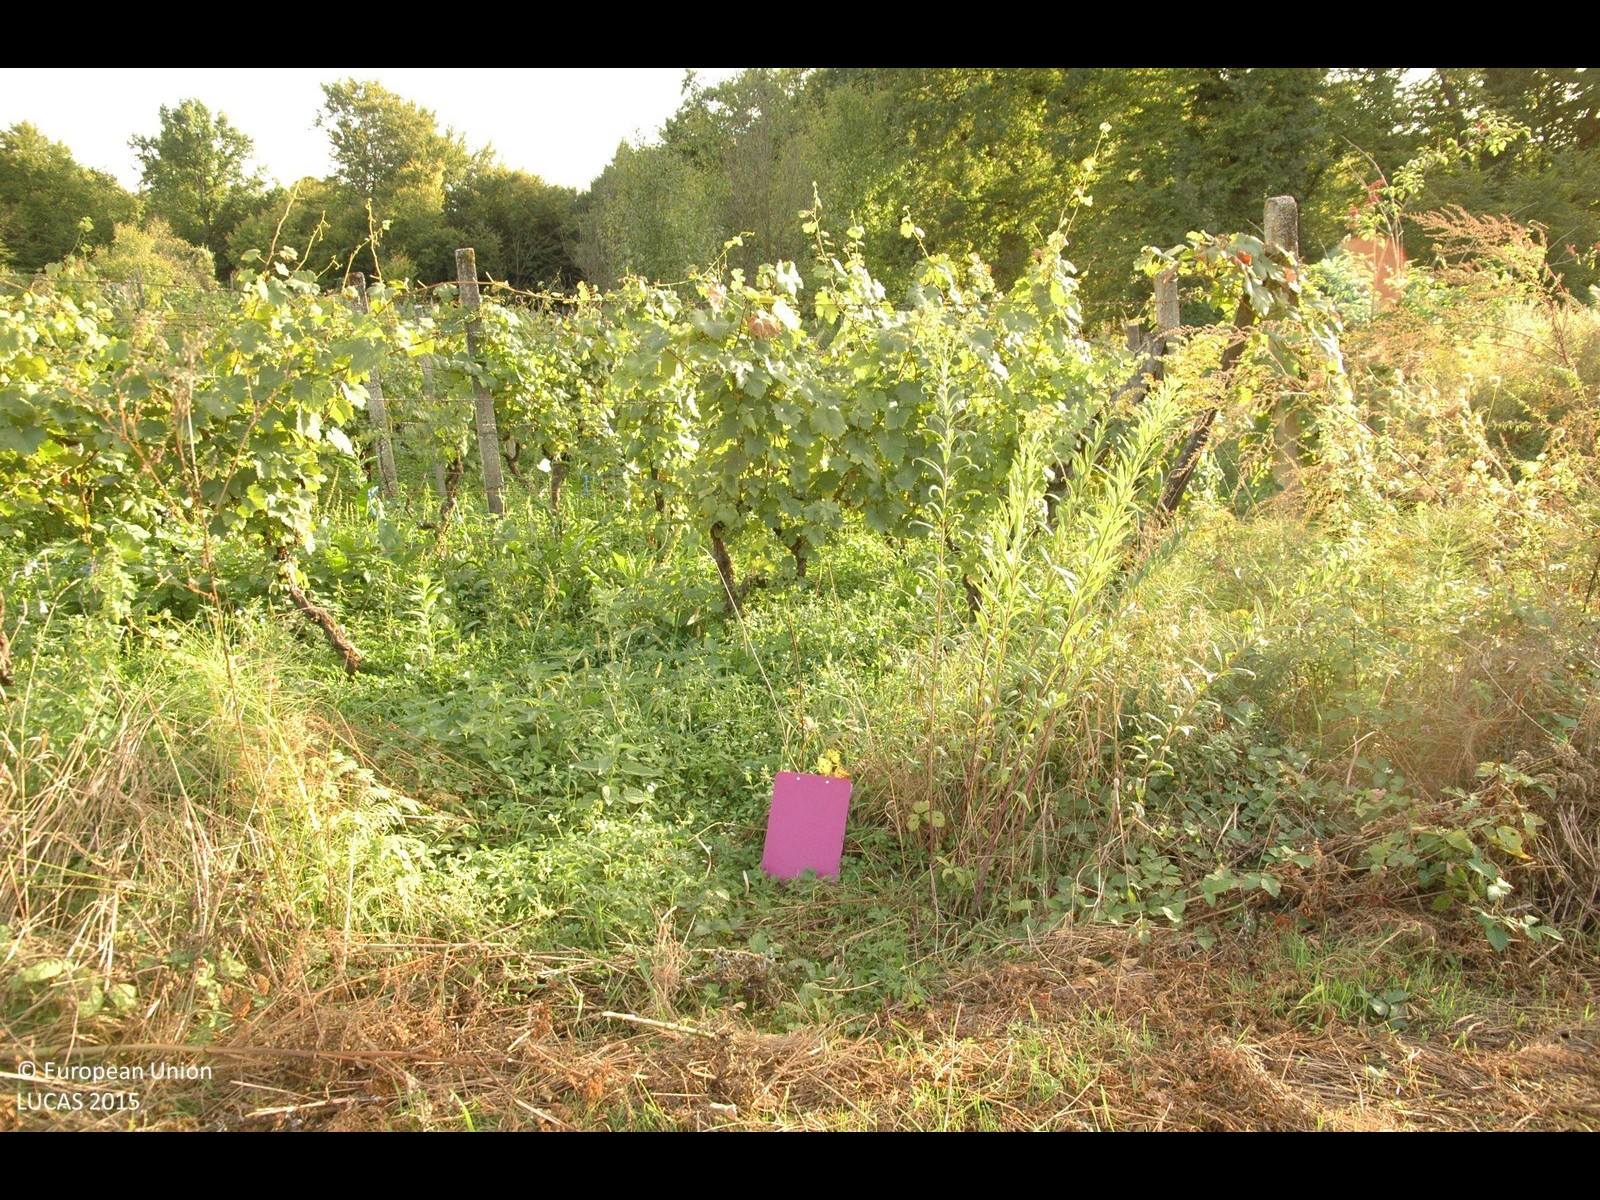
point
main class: Grassland
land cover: Grassland without tree/shrub cover
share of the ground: > 75 %
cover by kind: herbaceous plants 100 %
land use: Agriculture (excluding fallow land and kitchen gardens)
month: September
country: HR
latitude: 45.6085
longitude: 15.9339
